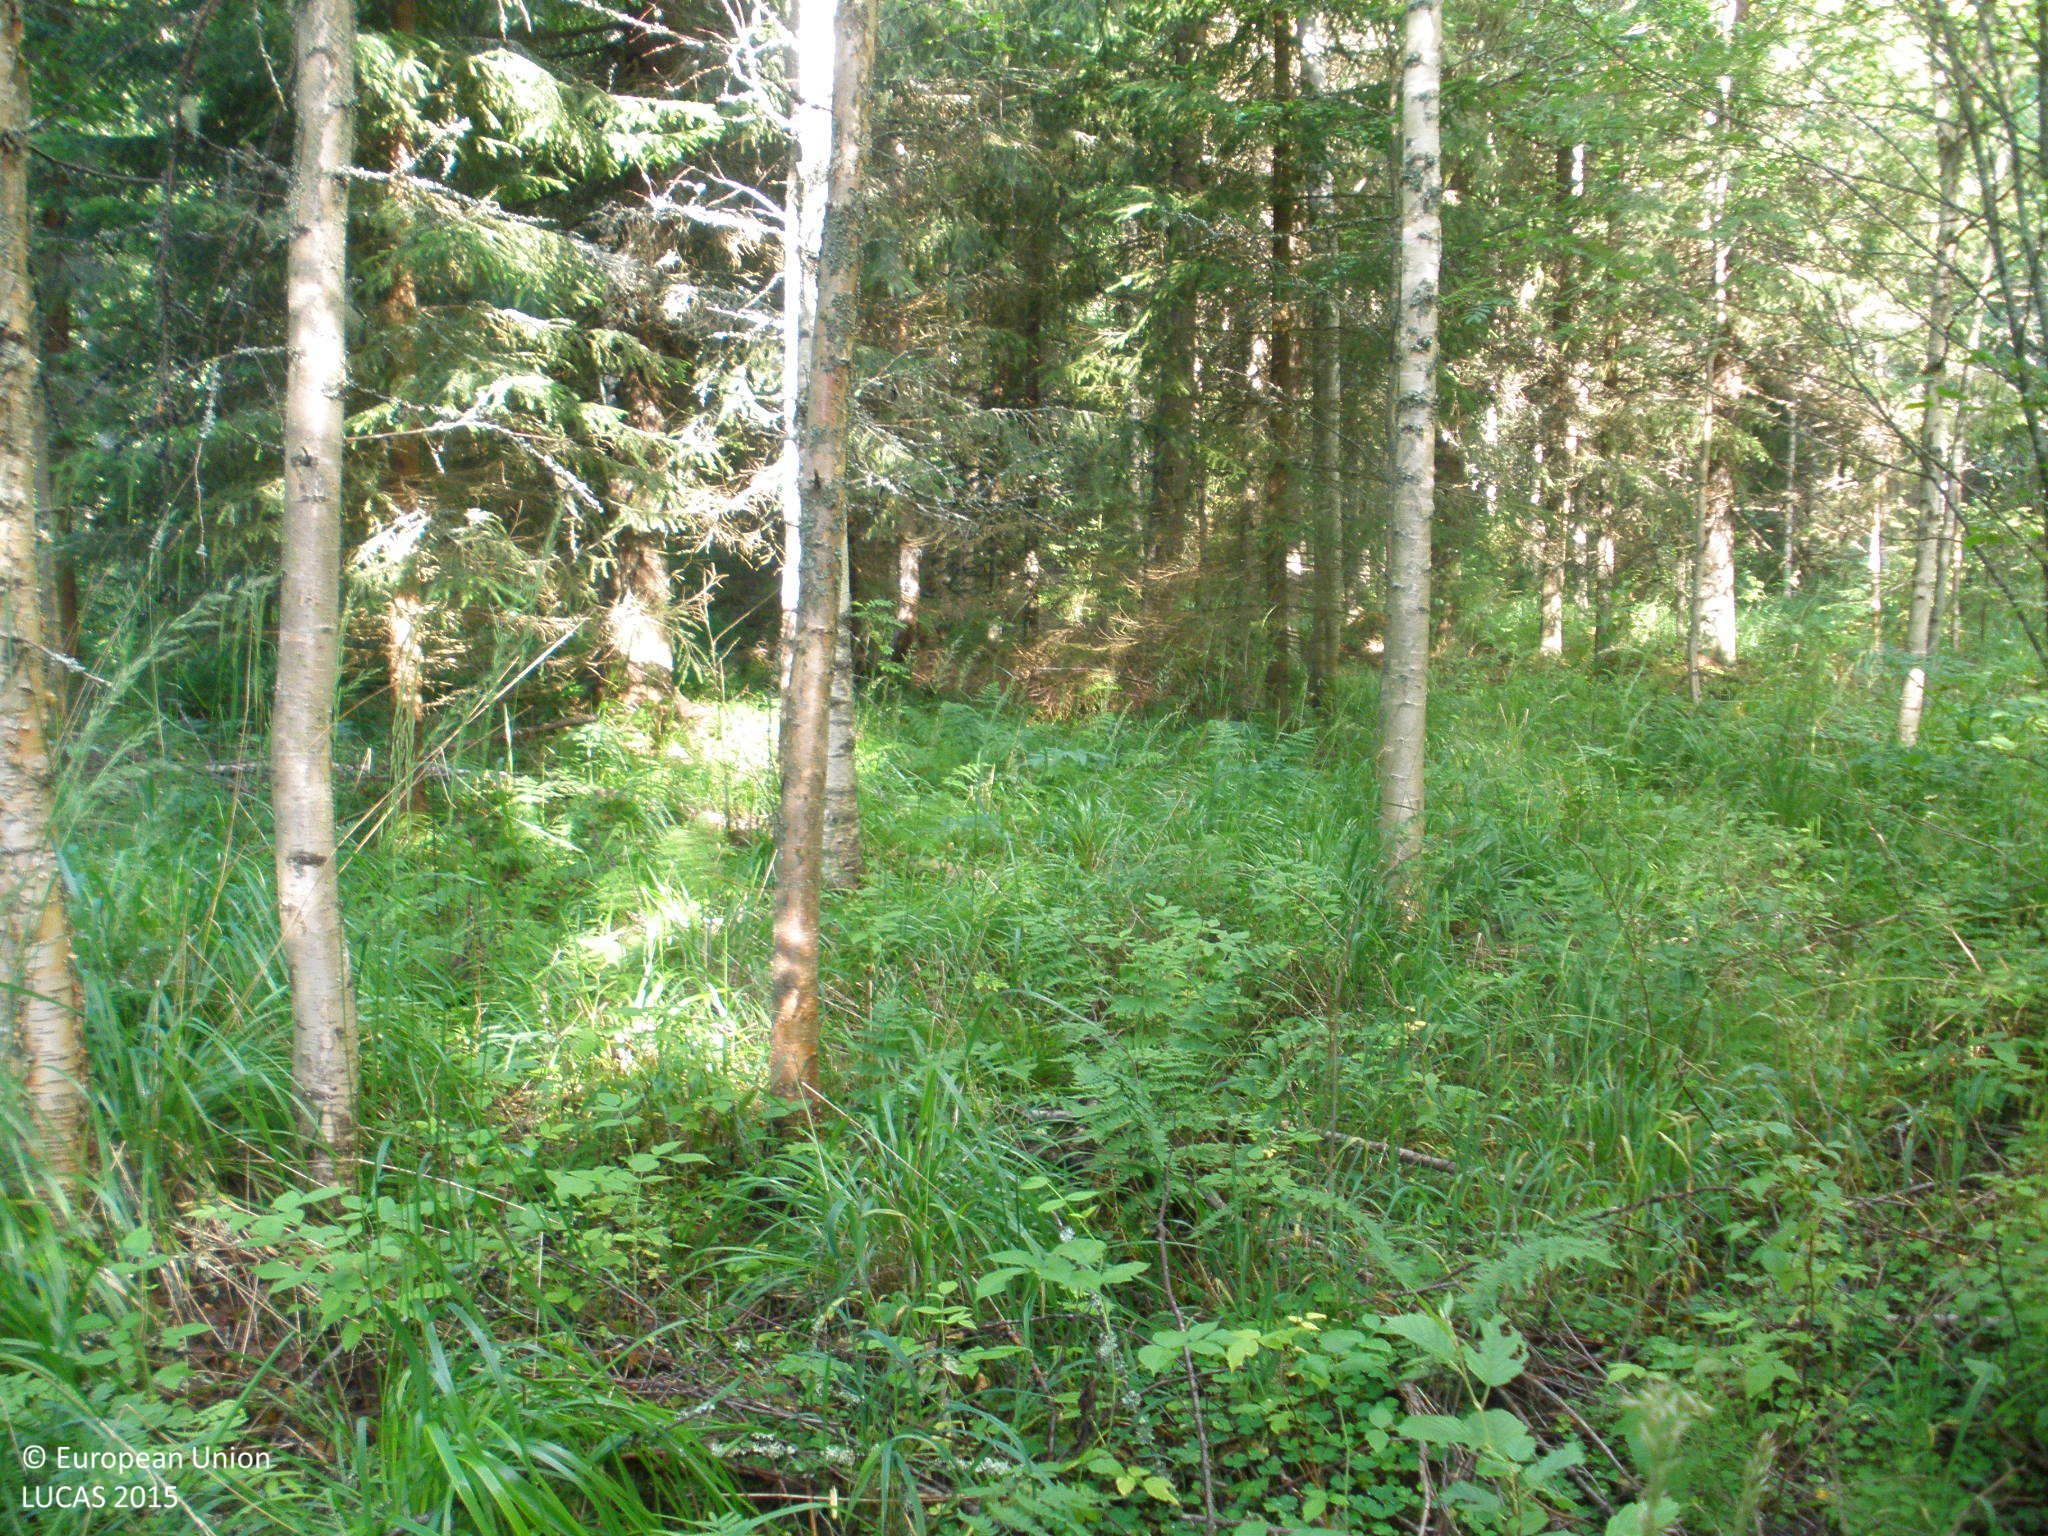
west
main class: Woodland
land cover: Spruce dominated mixed woodland
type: boreal forest
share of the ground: > 75 %
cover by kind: coniferous forest trees 55 %, broadleaved forest trees 30 %, herbaceous plants 10 %, shrubs 5 %
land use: Forestry
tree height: > 5 m
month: July
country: FI
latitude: 60.9826
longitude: 25.0661
